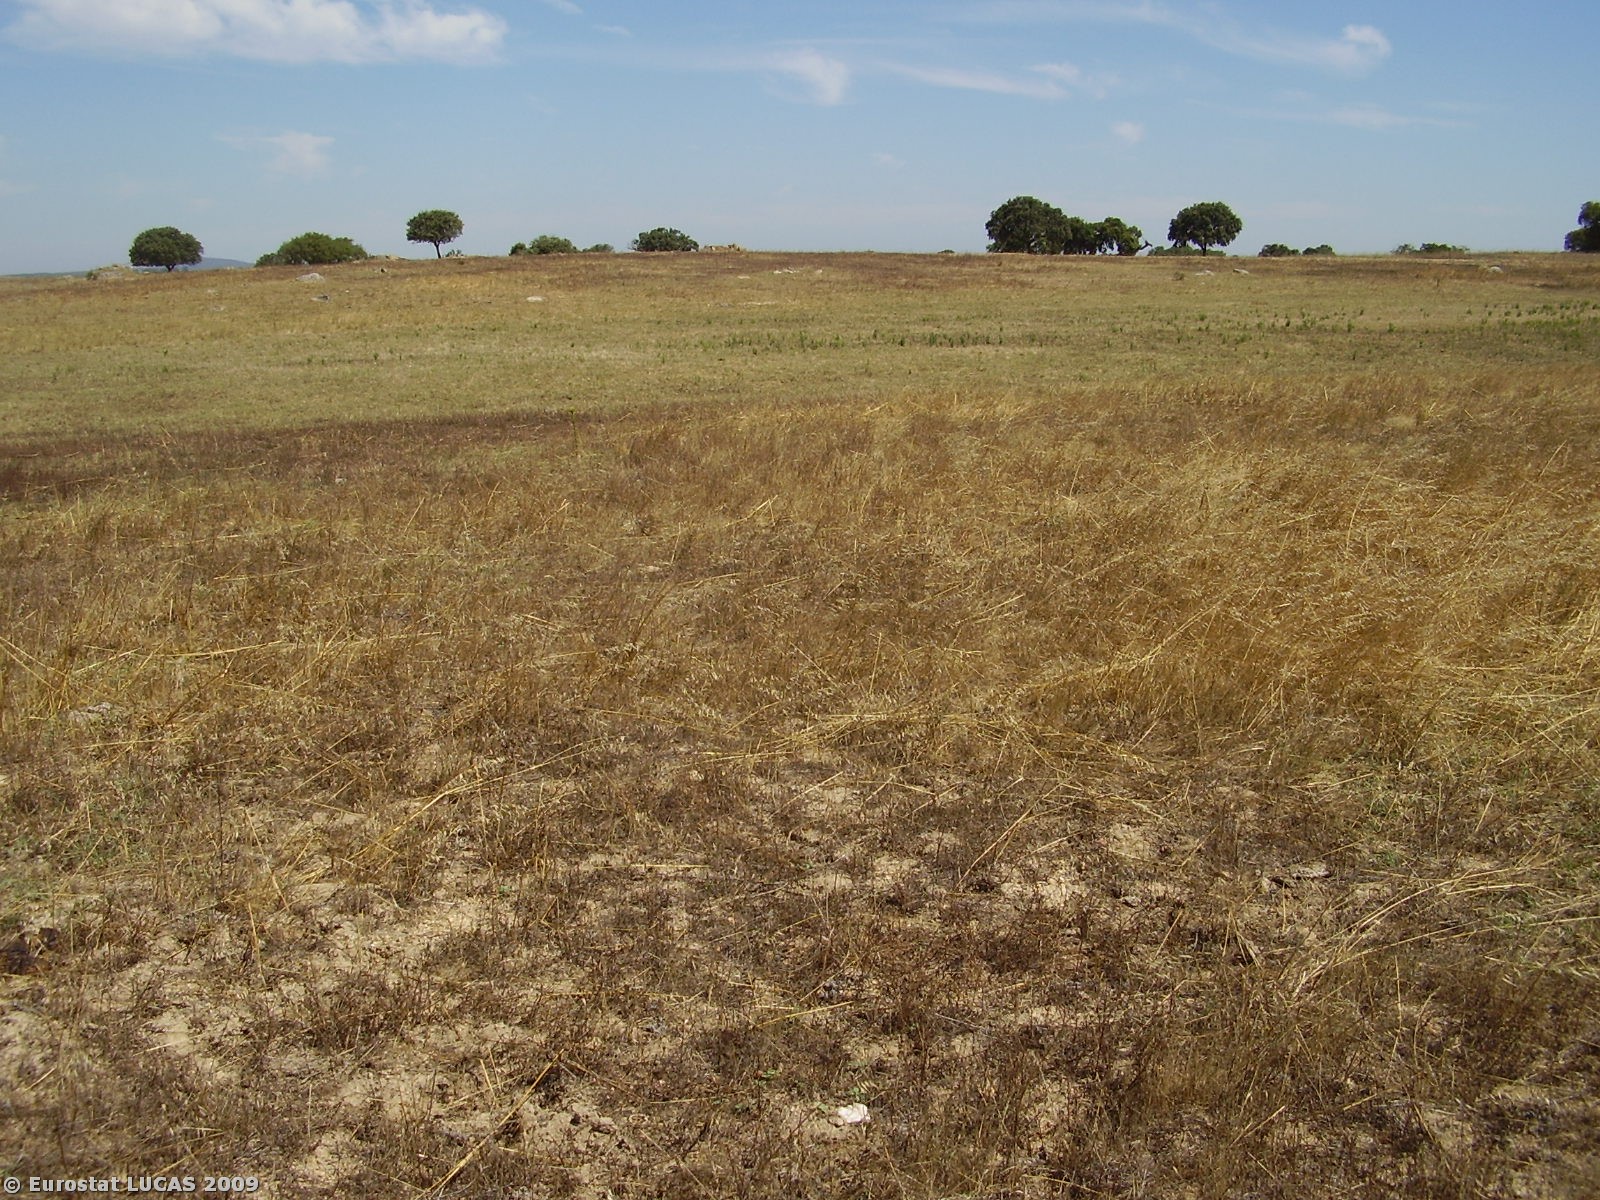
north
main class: Grassland
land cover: Grassland without tree/shrub cover
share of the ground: > 75 %
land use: Fallow land
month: July
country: PT
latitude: 38.7162
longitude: -7.9030
